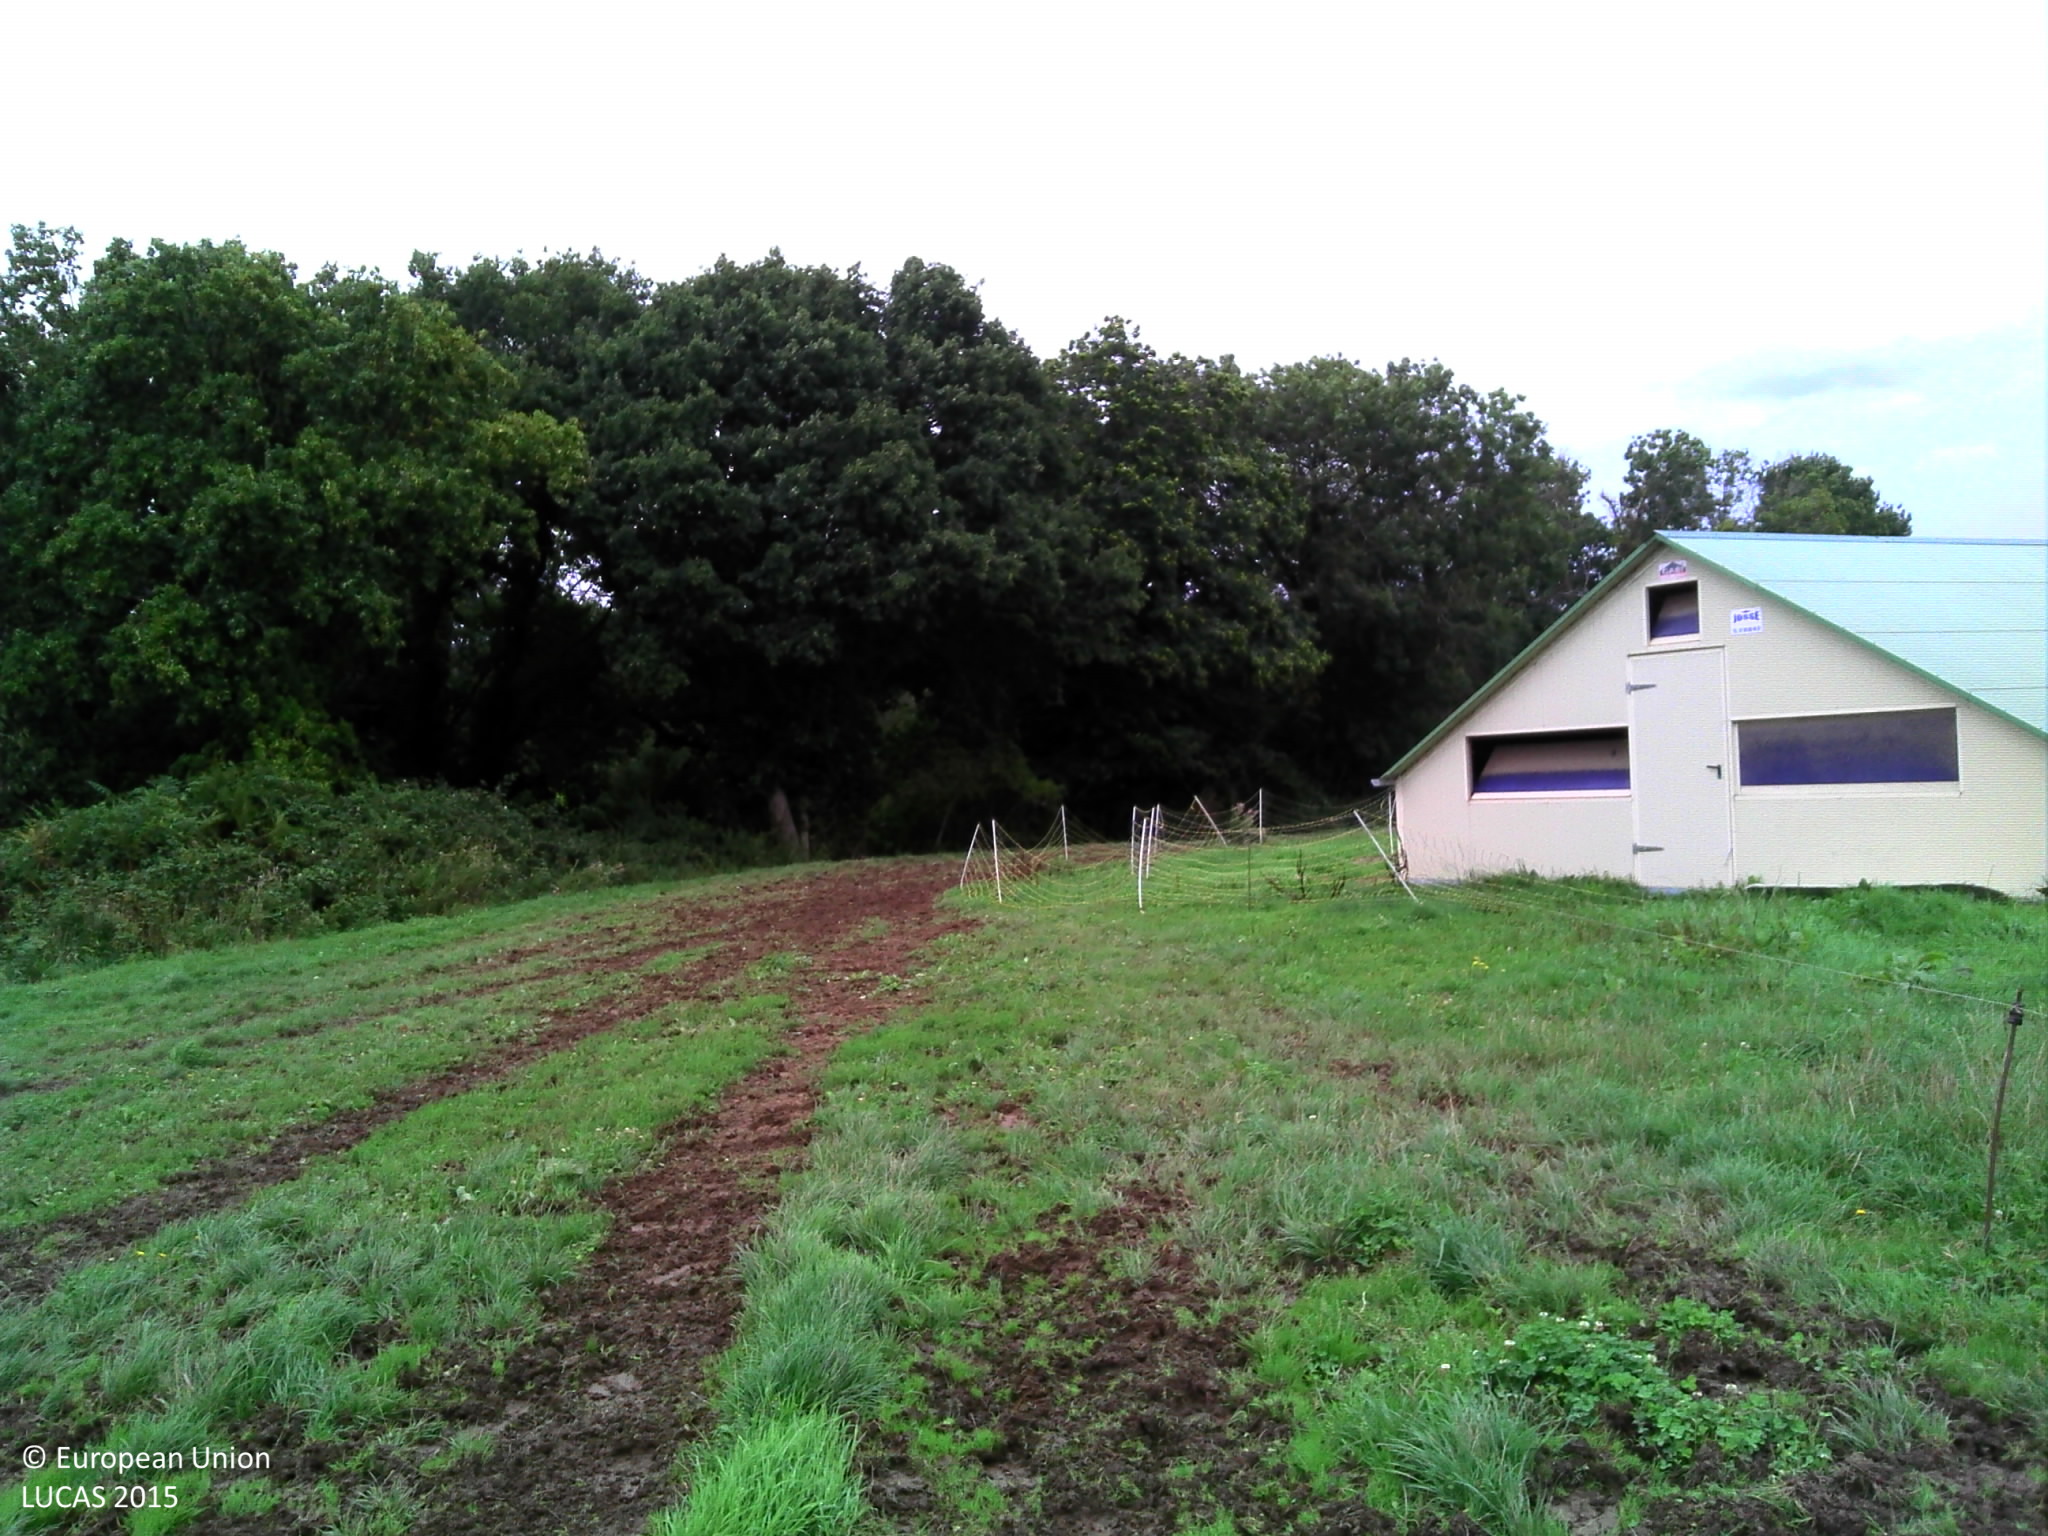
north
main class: Grassland
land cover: Grassland without tree/shrub cover
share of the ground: > 75 %
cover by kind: herbaceous plants 90 %, unconsolidated bare surface 10 %
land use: Agriculture (excluding fallow land and kitchen gardens)
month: August
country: FR
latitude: 48.5725
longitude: -2.1045
